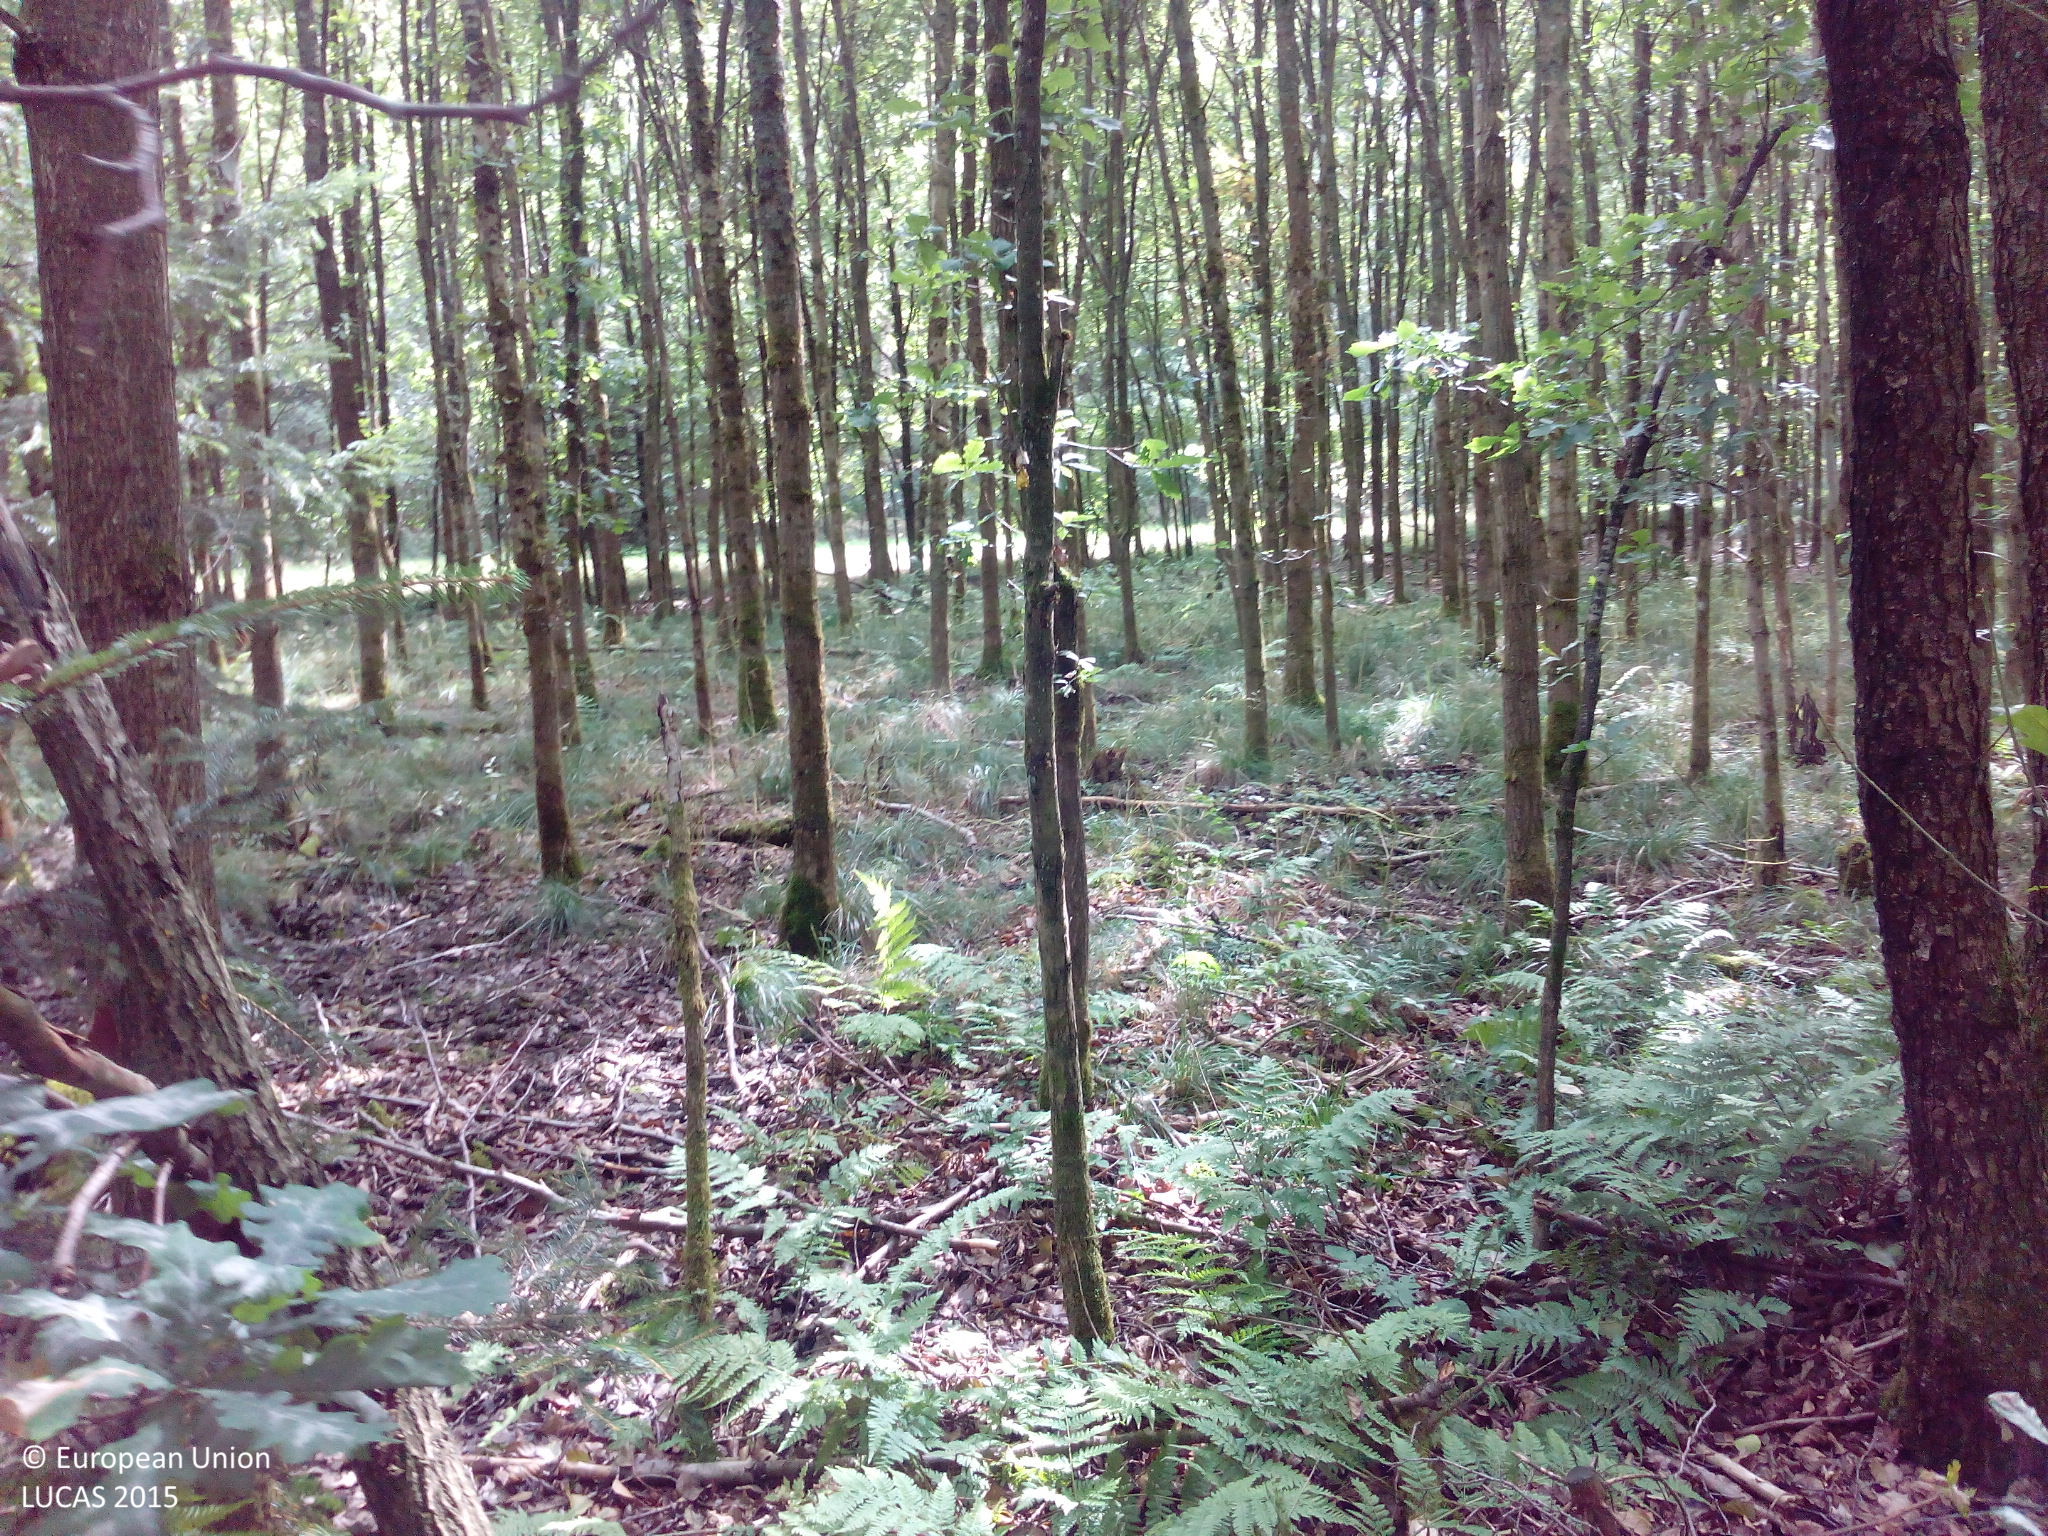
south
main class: Woodland
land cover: Broadleaved woodland
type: mesophytic deciduous forest
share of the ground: > 75 %
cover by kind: broadleaved forest trees 80 %, coniferous forest trees 5 %, herbaceous plants 5 %, lichens and mosses 5 %, unconsolidated bare surface 5 %
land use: Forestry
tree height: > 5 m
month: August
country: DE
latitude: 50.0675
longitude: 7.5275
